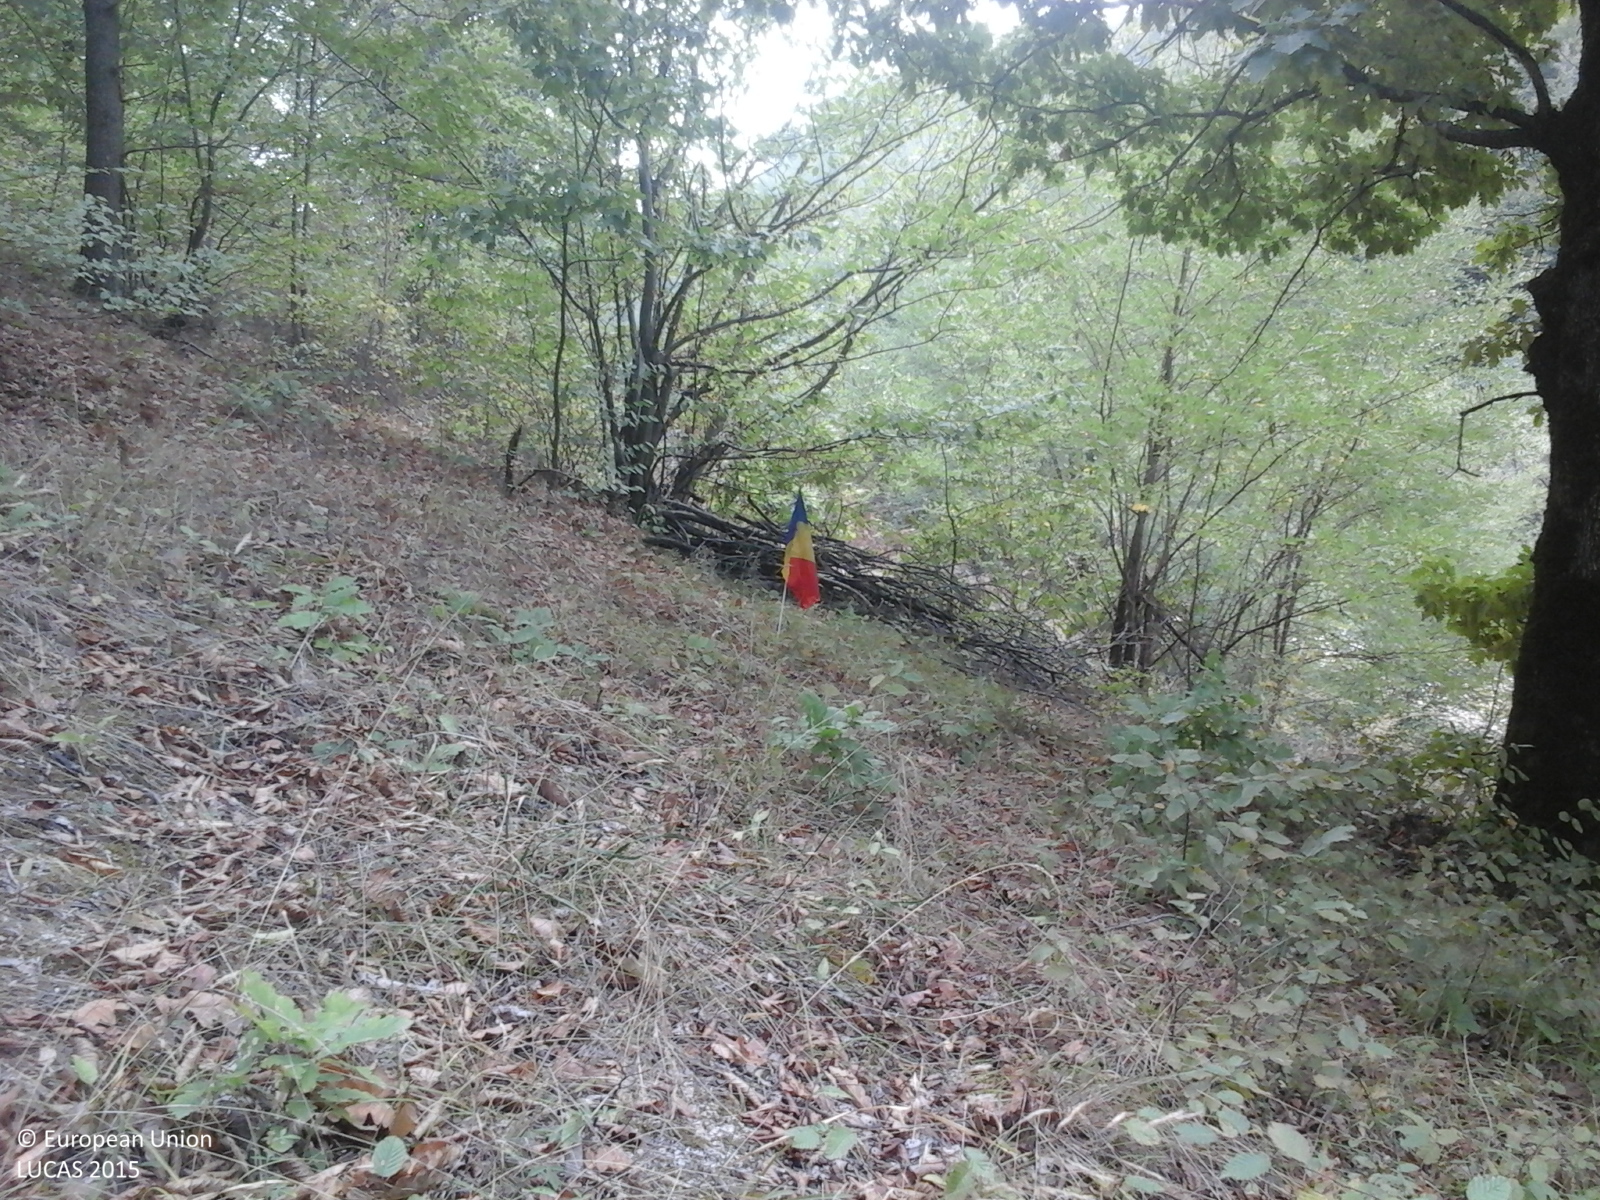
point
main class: Woodland
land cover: Broadleaved woodland
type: acidophilous oak and oak-birch forest
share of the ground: > 75 %
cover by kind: broadleaved forest trees 100 %
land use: Forestry
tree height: > 5 m
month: September
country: RO
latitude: 45.3873
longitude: 22.1090
